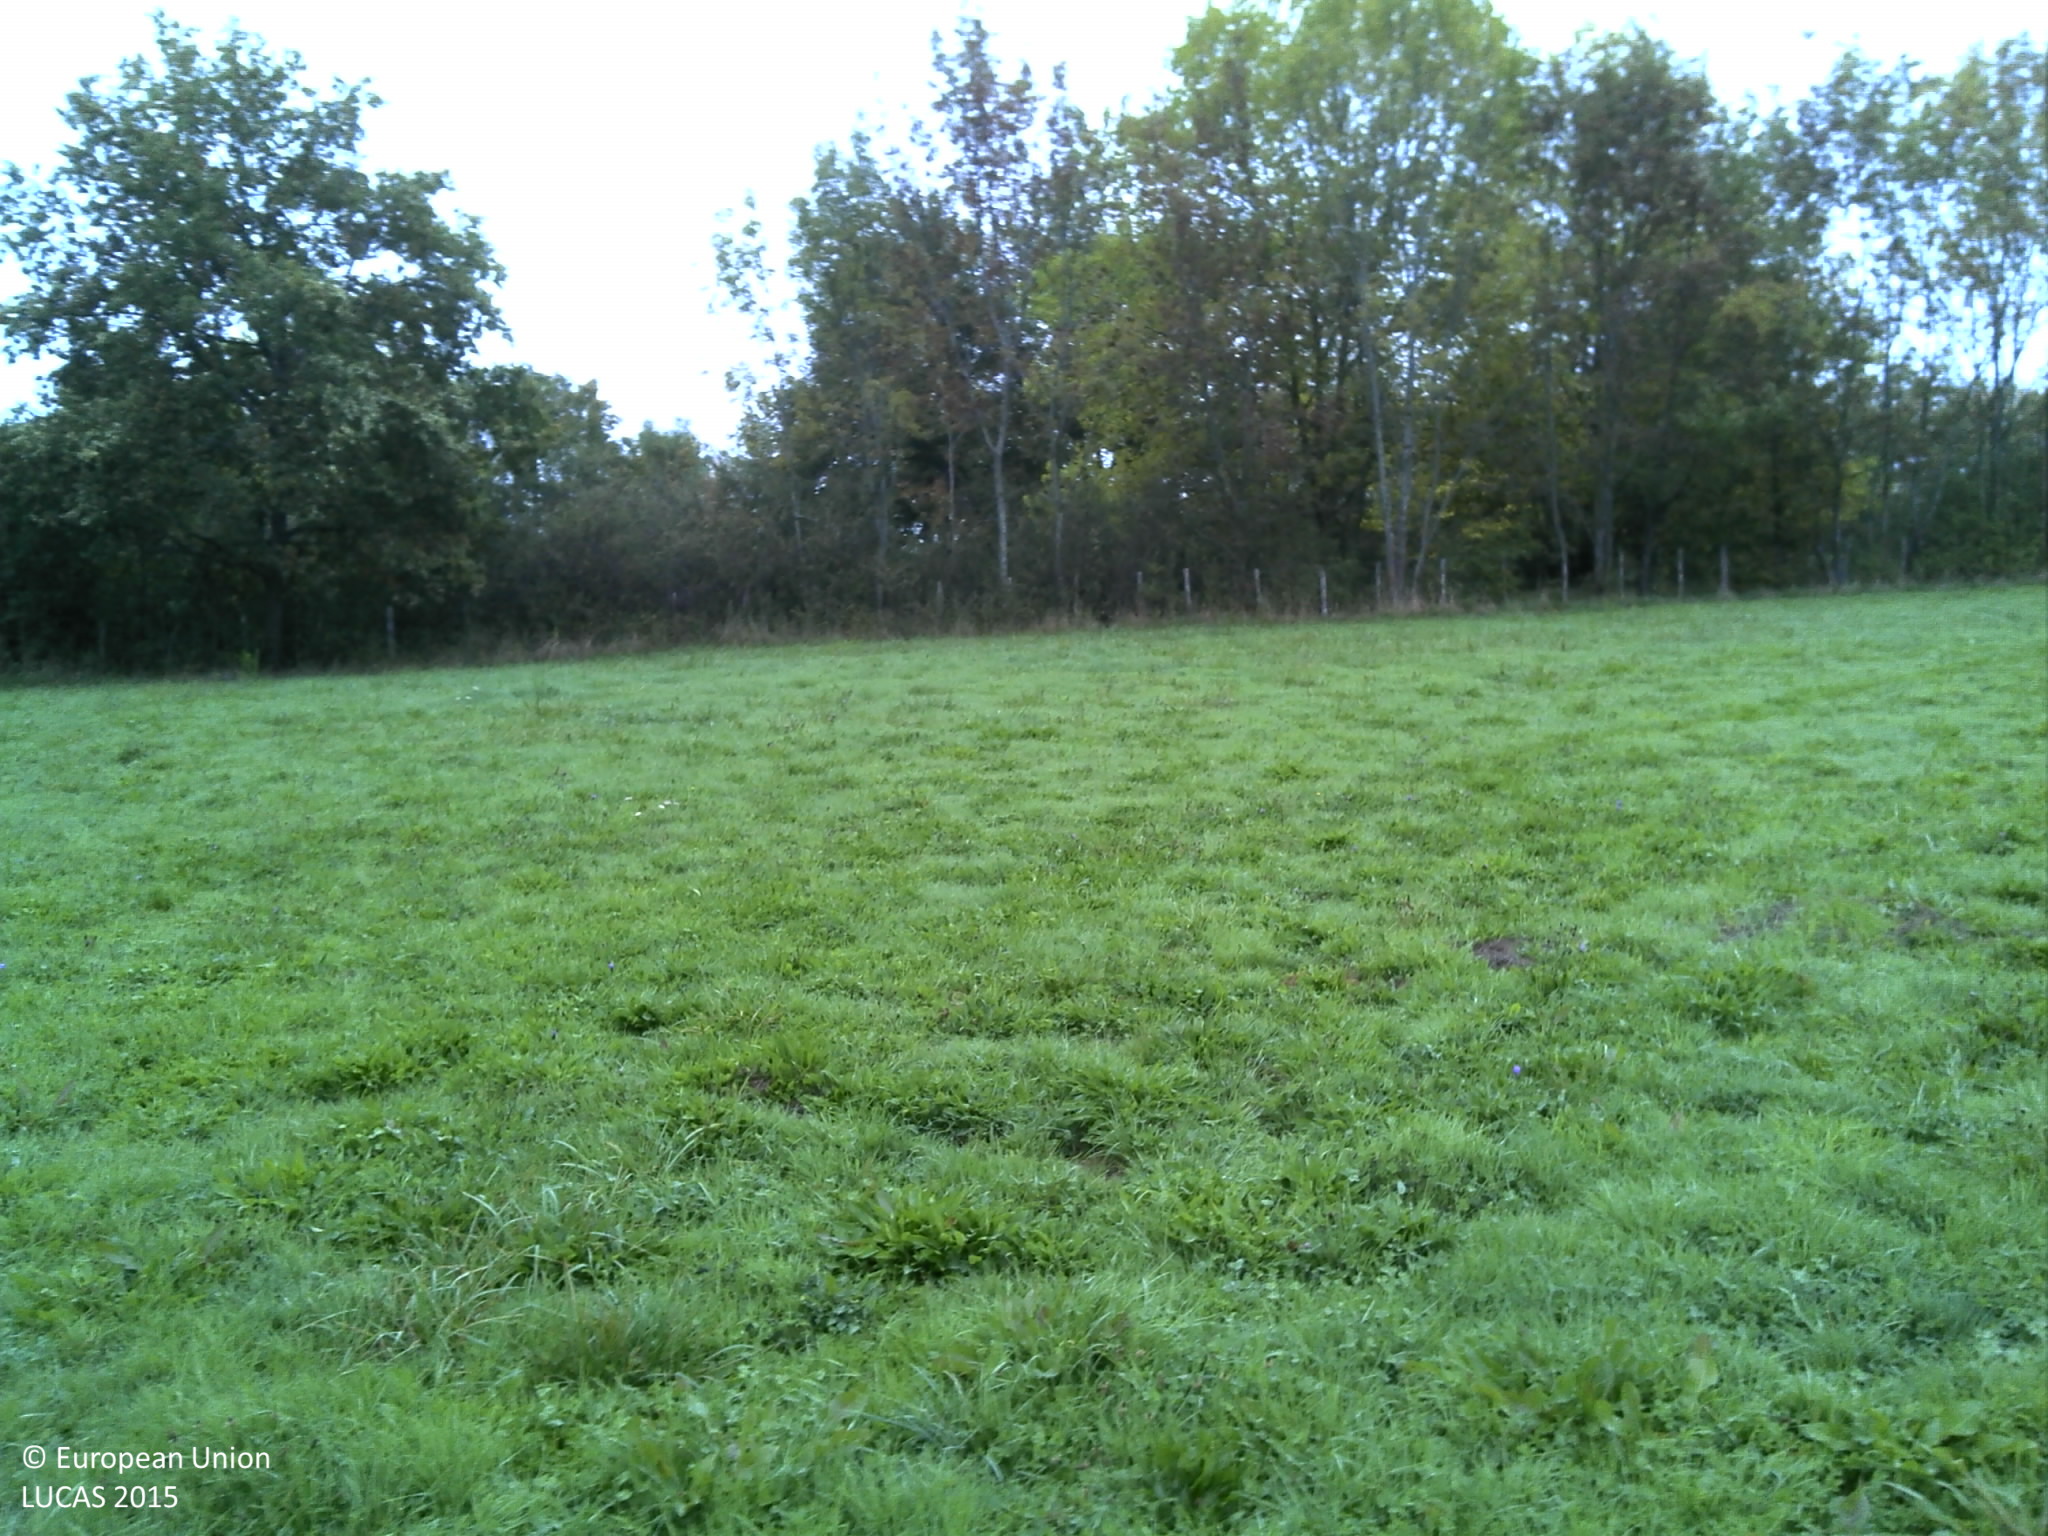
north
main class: Grassland
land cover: Grassland without tree/shrub cover
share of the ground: > 75 %
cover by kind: herbaceous plants 100 %
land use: Agriculture (excluding fallow land and kitchen gardens)
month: October
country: FR
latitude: 46.4238
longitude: 4.8102
